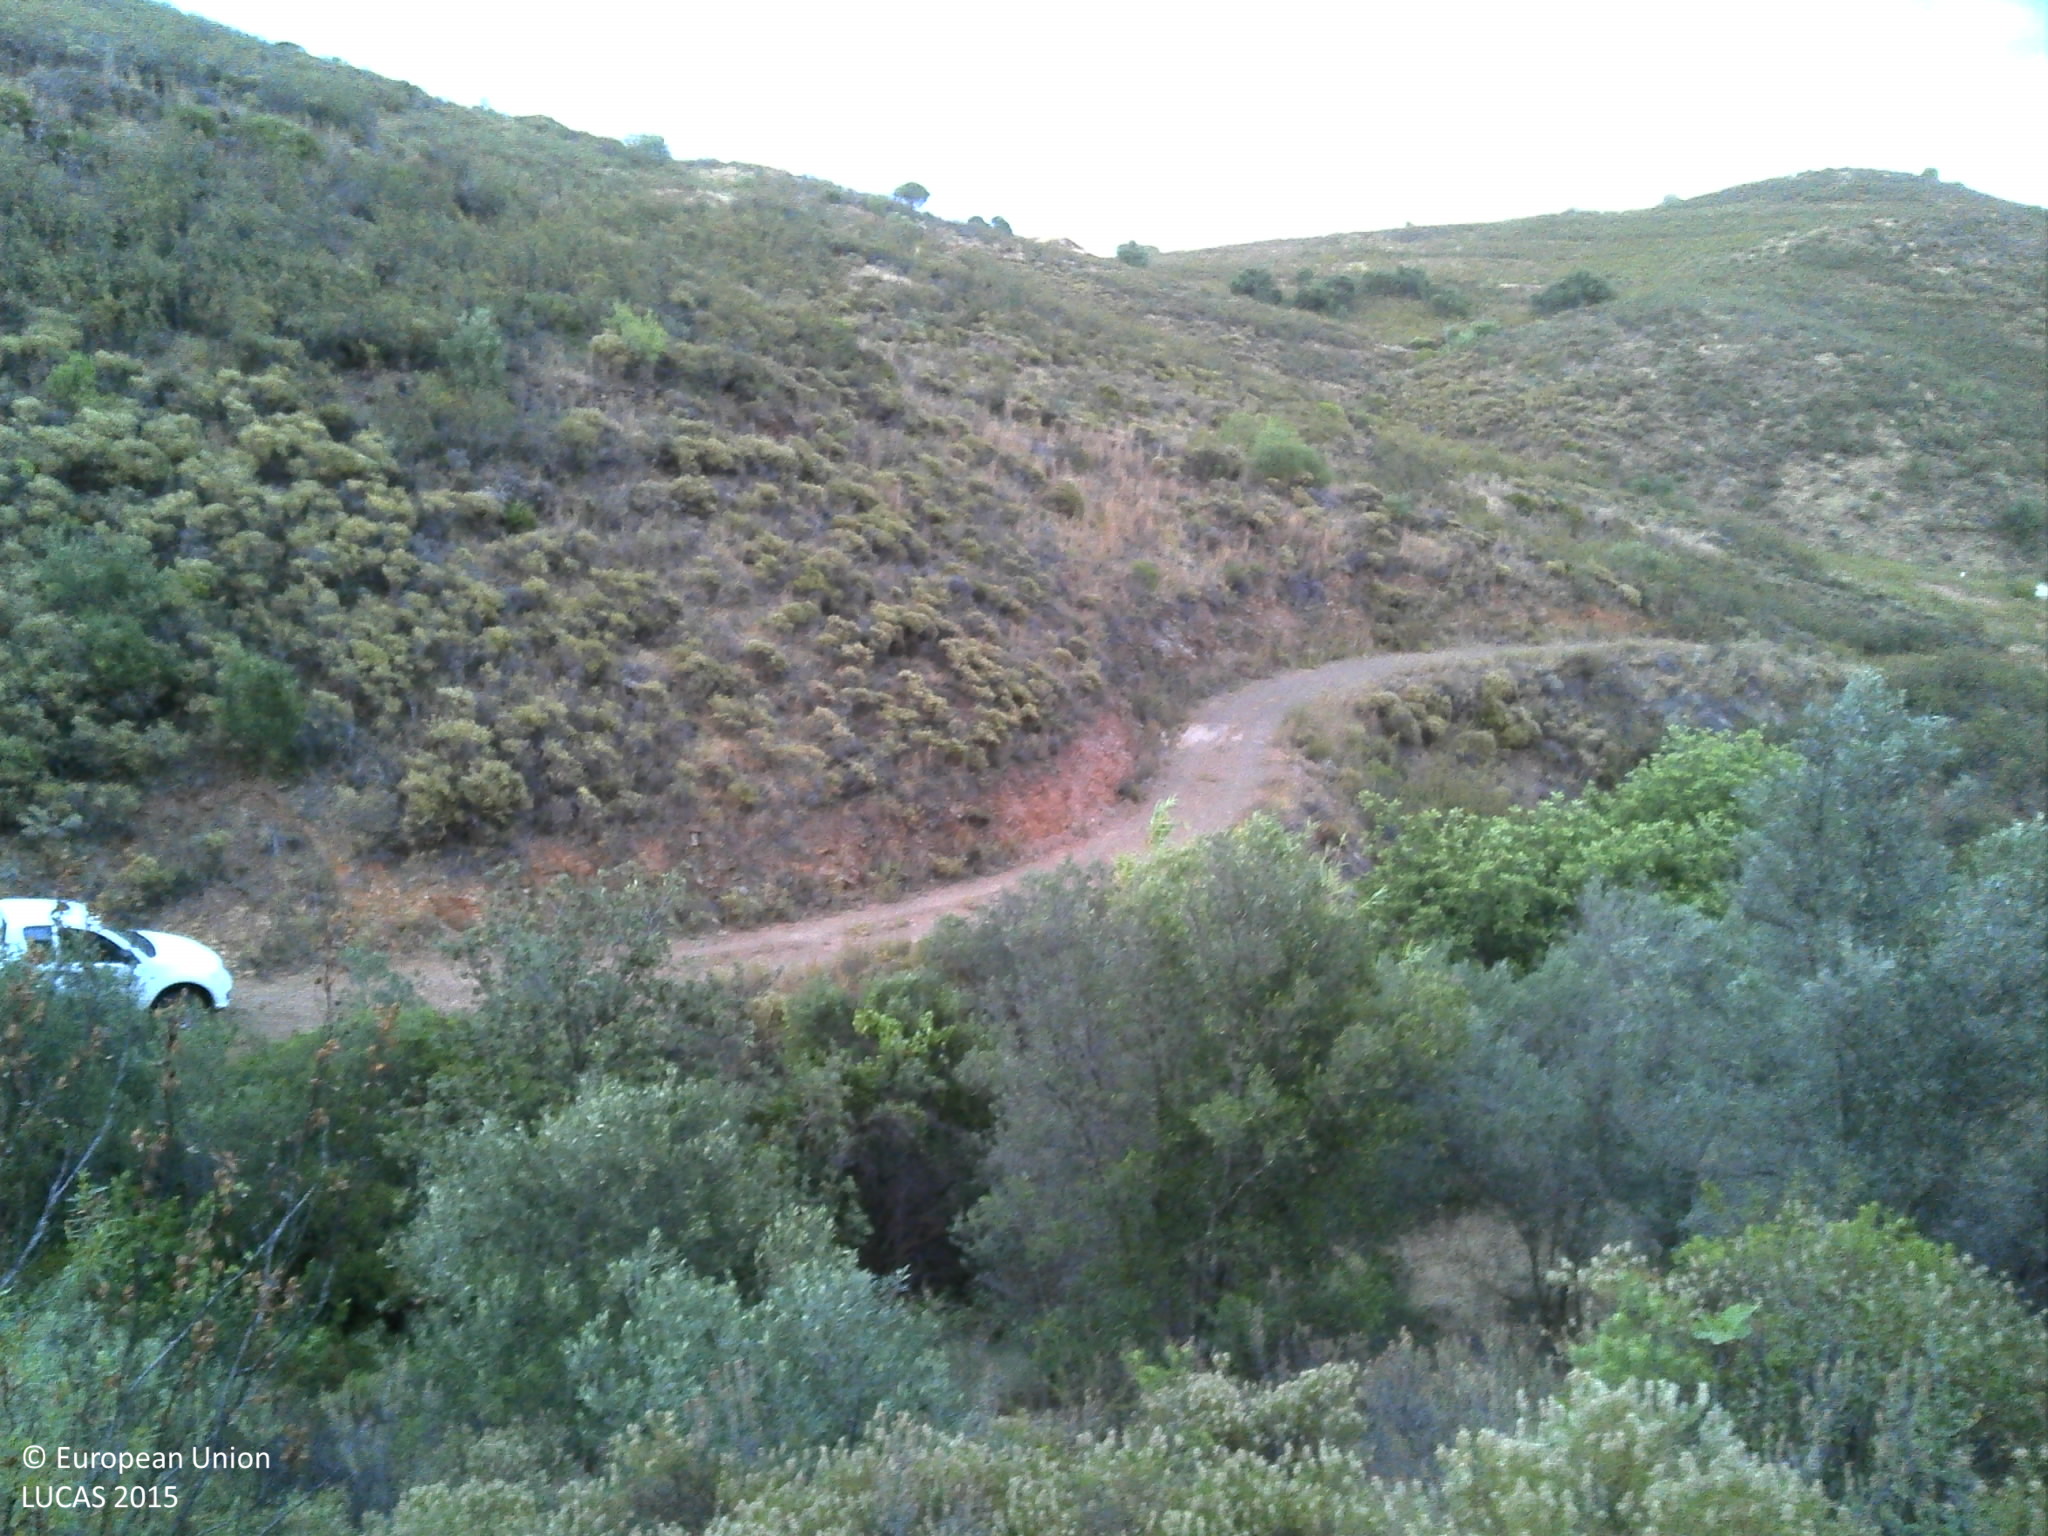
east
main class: Shrubland
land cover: Shrubland with sparse tree cover
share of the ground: > 75 %
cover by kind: shrubs 95 %, broadleaved forest trees 5 %
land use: Abandoned areas
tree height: < 5 m
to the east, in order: Shrubland with sparse tree cover; Abandoned hedges; Rivers and streams; Shrubland with sparse tree cover; Tracks; Shrubland without tree cover; Grassland without tree/shrub cover; Shrubland without tree cover; Tracks; Shrubland without tree cover; Rivers and streams; Shrubland with sparse tree cover
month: June
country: PT
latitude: 37.1691
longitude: -7.6763
